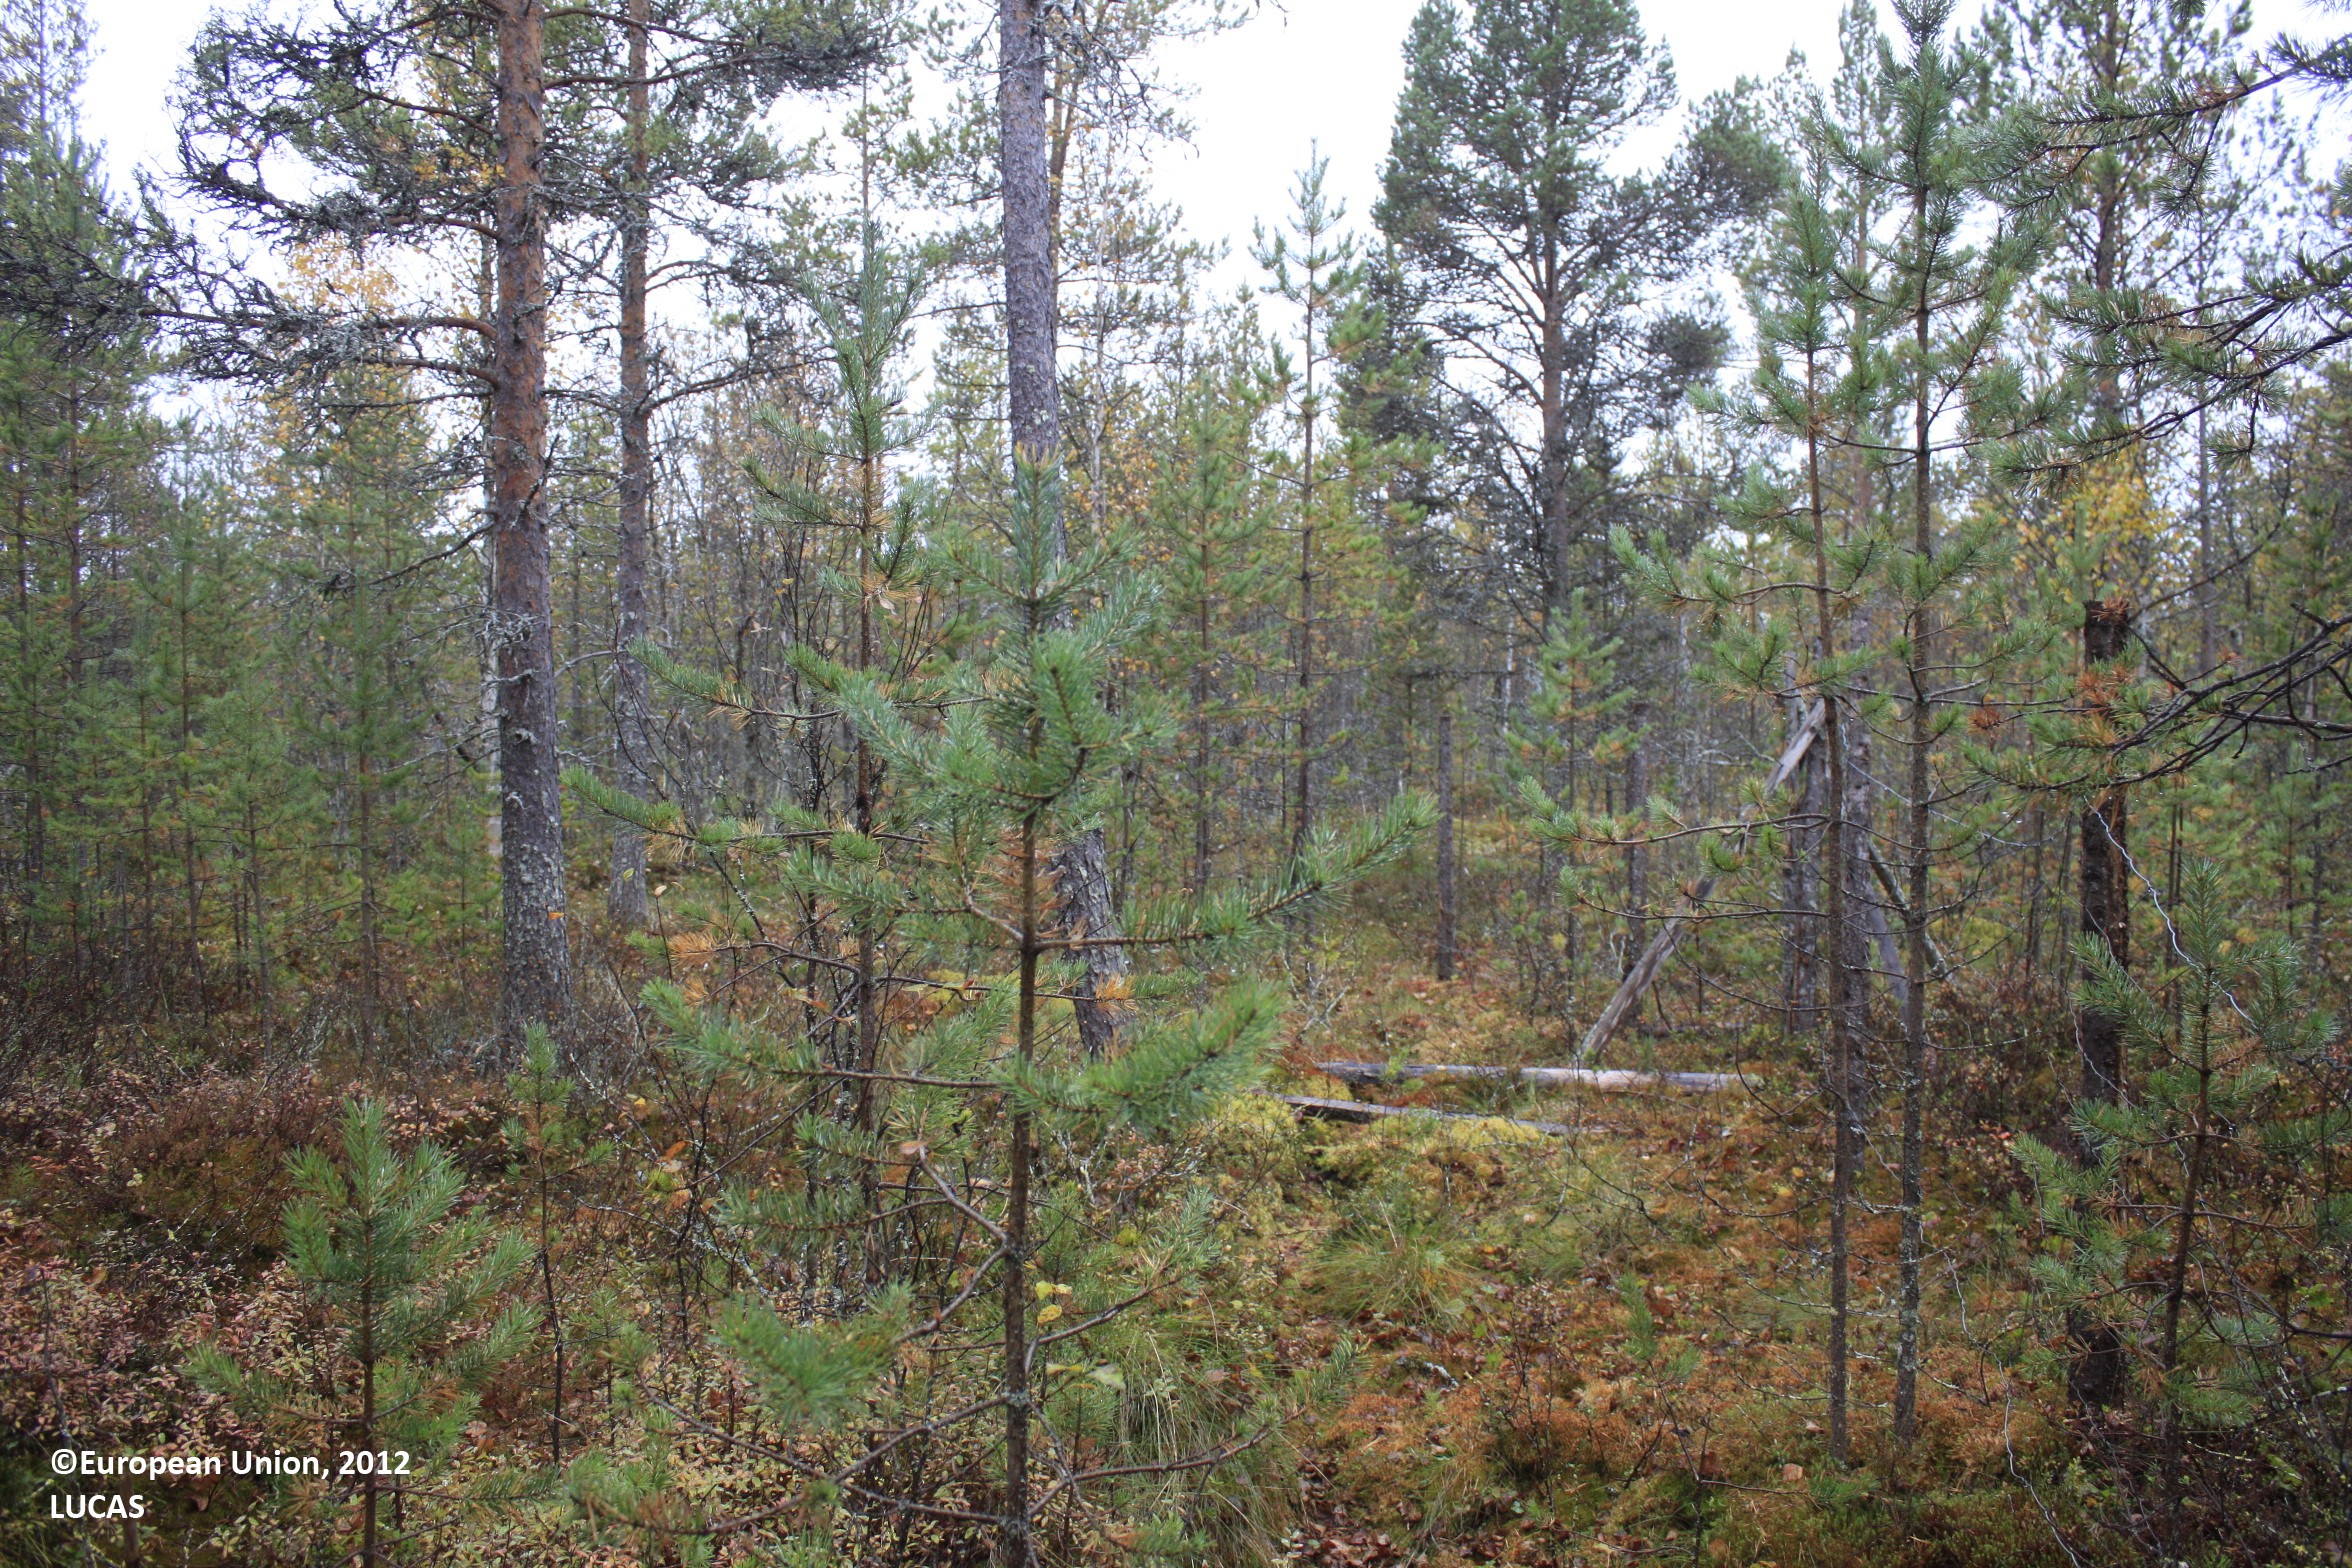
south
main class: Woodland
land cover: Pine dominated mixed woodland
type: mire and swamp forests
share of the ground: 25 - 50 %
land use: Forestry
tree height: > 5 m
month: September
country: FI
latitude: 65.7495
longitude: 27.4264
